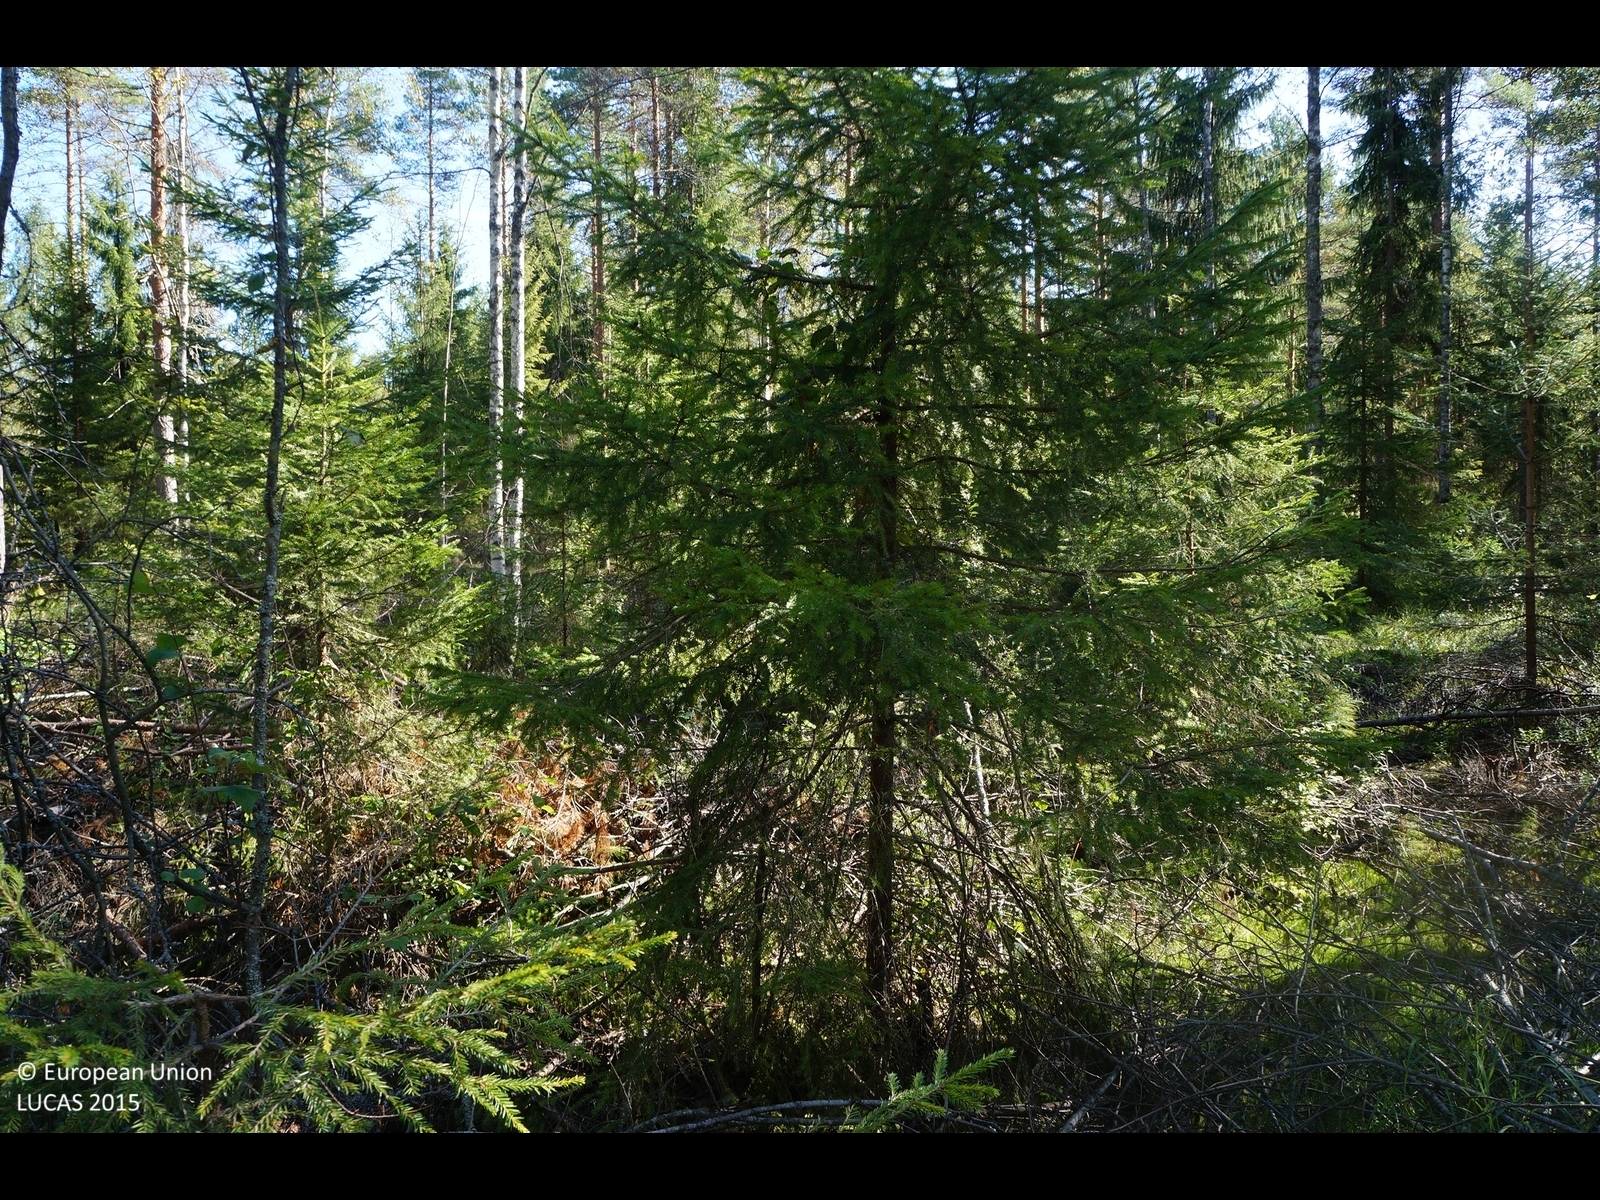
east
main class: Woodland
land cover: Other mixed woodland
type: boreal forest
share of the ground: 50 - 75 %
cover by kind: coniferous forest trees 40 %, shrubs 30 %, broadleaved forest trees 20 %, lichens and mosses 10 %
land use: Forestry
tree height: > 5 m
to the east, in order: Other mixed woodland; Ditches and canals; Other mixed woodland; Ditches and canals; Other mixed woodland; Ditches and canals; Spruce dominated mixed woodland; Other mixed woodland; Ditches and canals; Other mixed woodland; Pine dominated mixed woodland; Ditches and canals; Other mixed woodland; Ditches and canals; Other mixed woodland; Other coniferous woodland; Other mixed woodland; Ditches and canals; Other mixed woodland
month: September
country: FI
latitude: 63.8615
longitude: 24.0448
